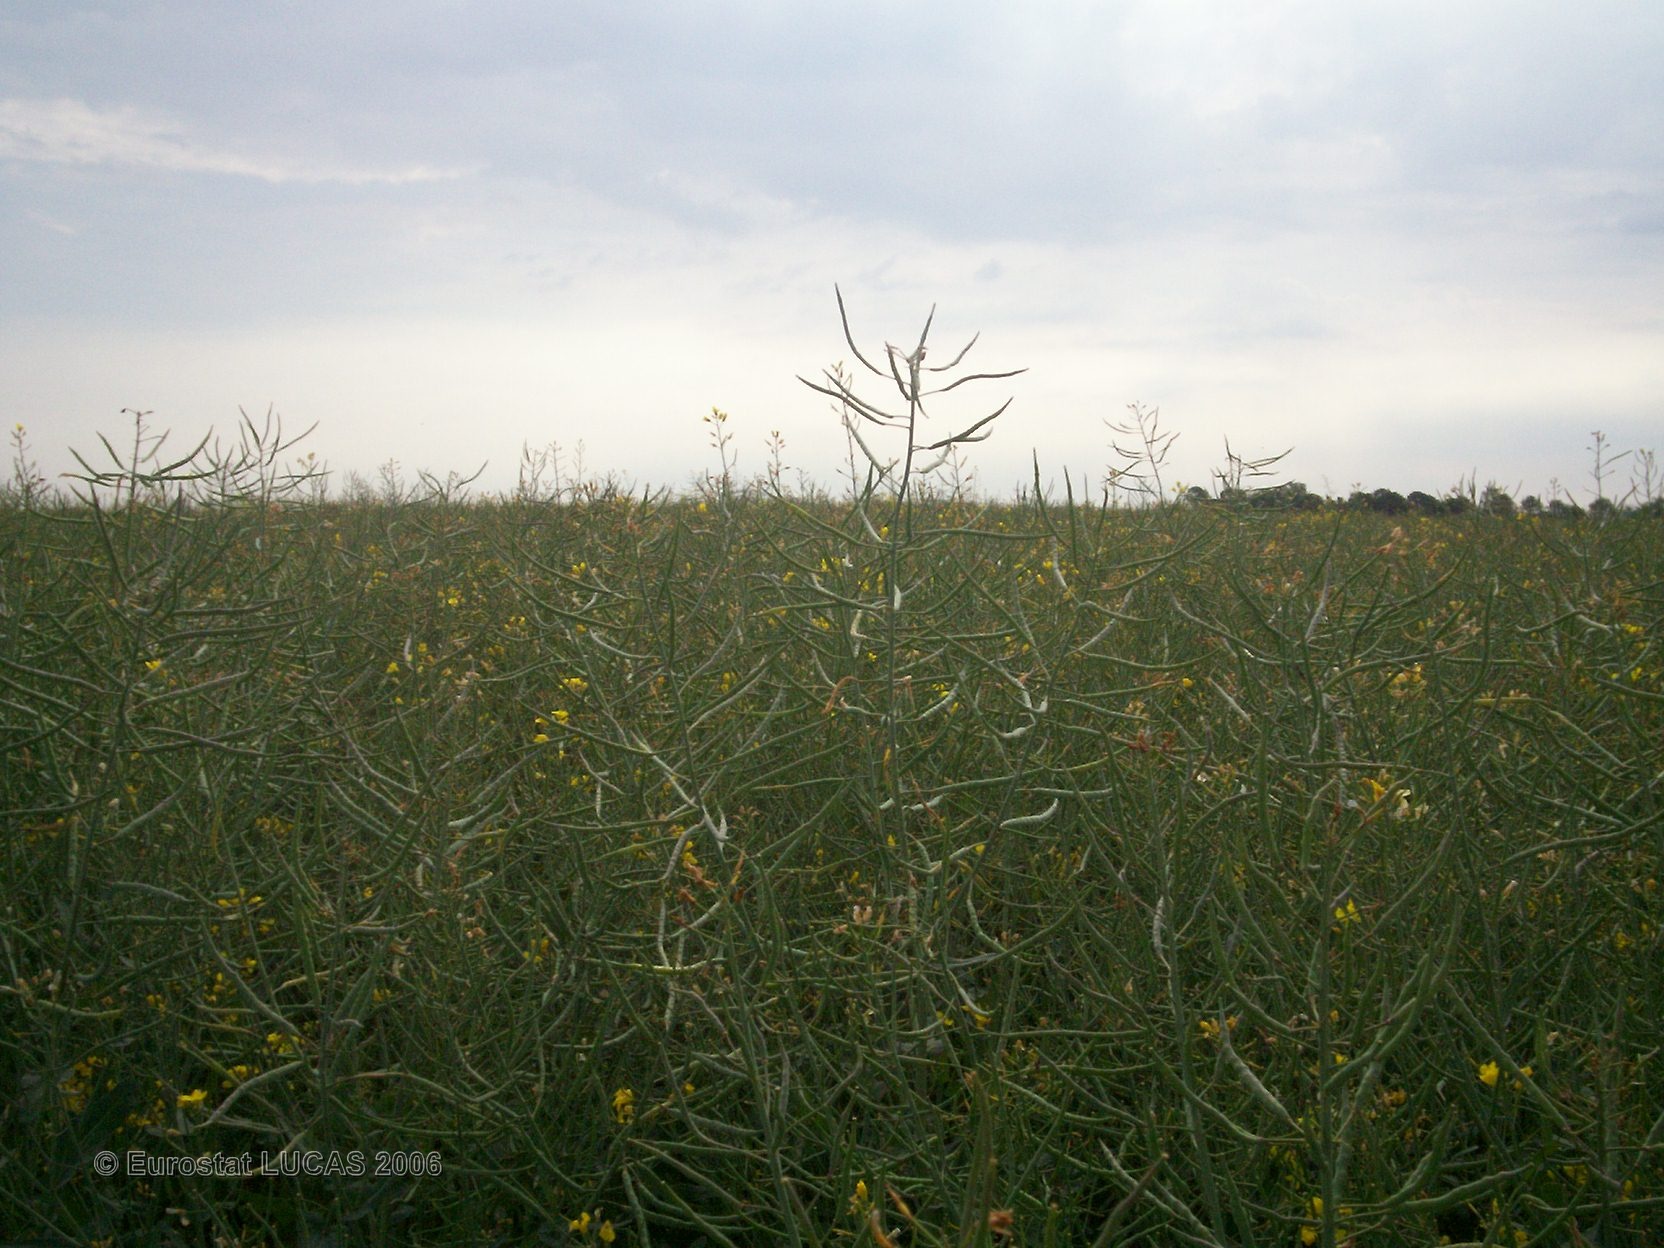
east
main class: Cropland
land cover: Rape and turnip rape
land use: Agriculture (excluding fallow land and kitchen gardens)
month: May
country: FR
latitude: 46.1135
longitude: -0.2309
